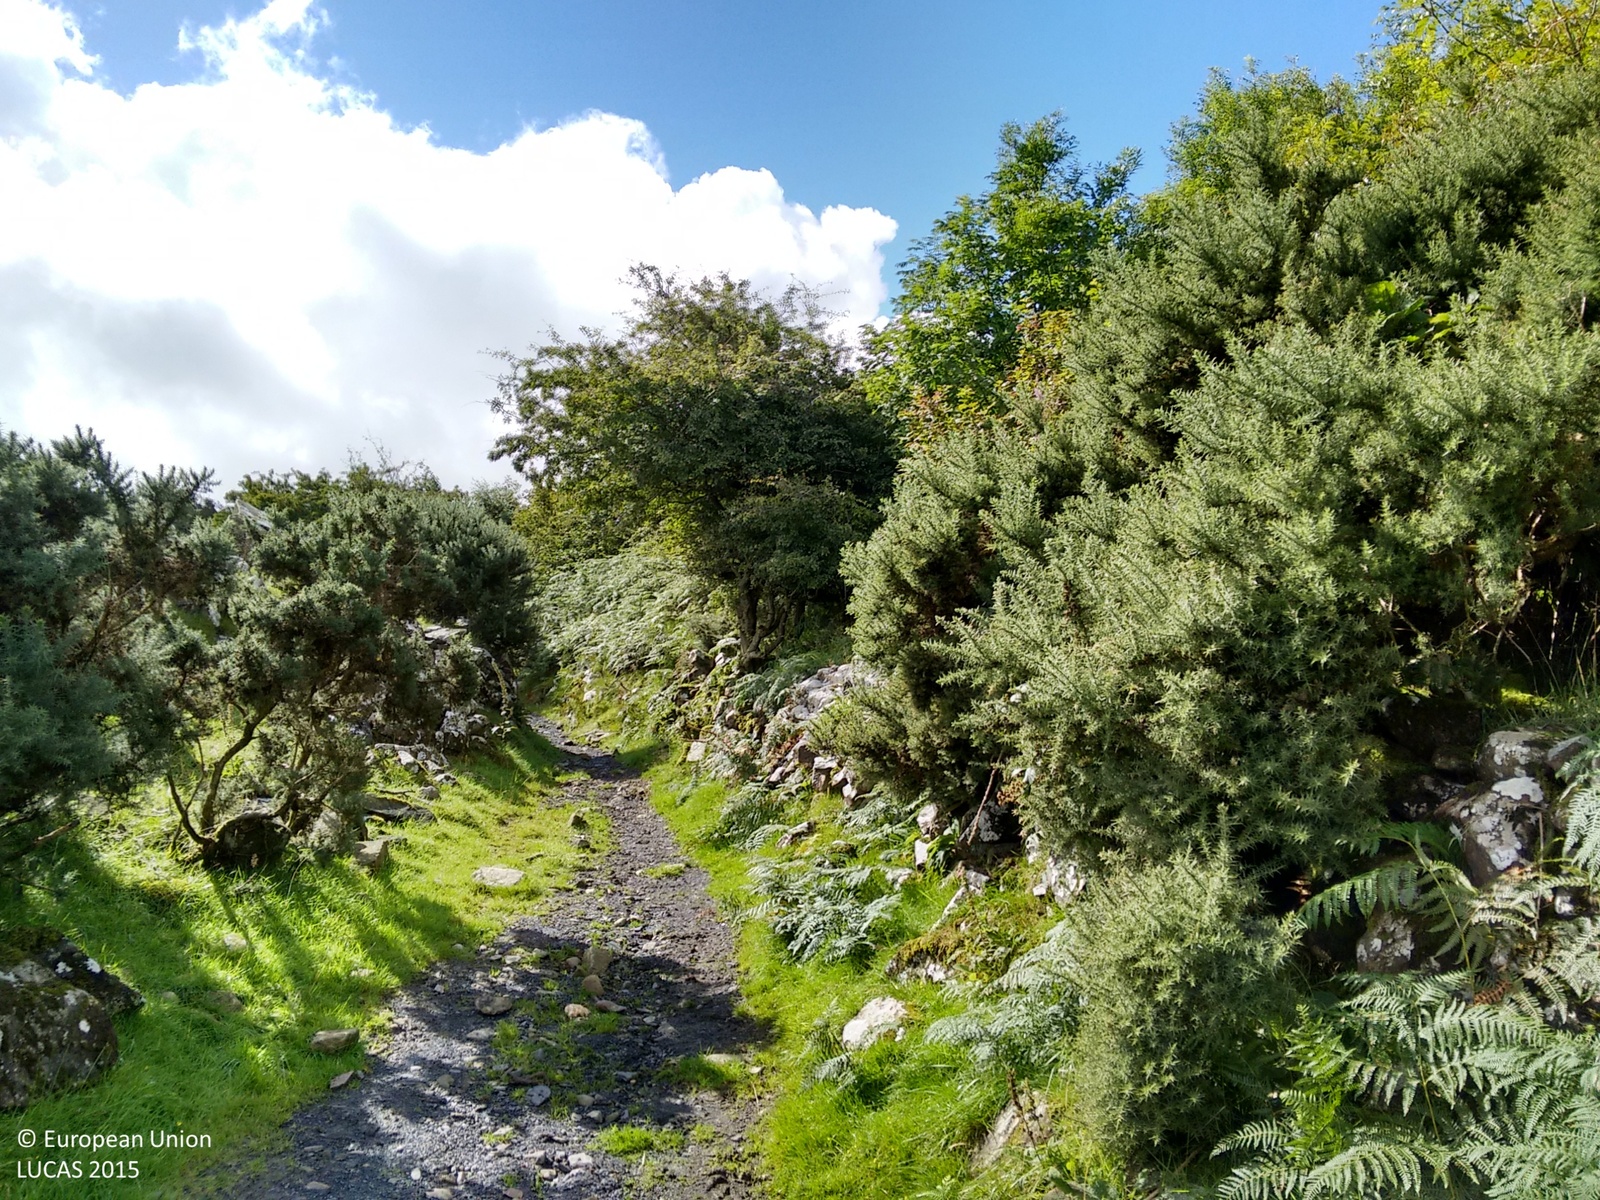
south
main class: Woodland
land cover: Broadleaved woodland
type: mesophytic deciduous forest
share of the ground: > 75 %
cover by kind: broadleaved forest trees 80 %, shrubs 20 %
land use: Semi-natural and natural areas not in use
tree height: > 5 m
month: August
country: GB
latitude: 52.0009
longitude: -4.8695
